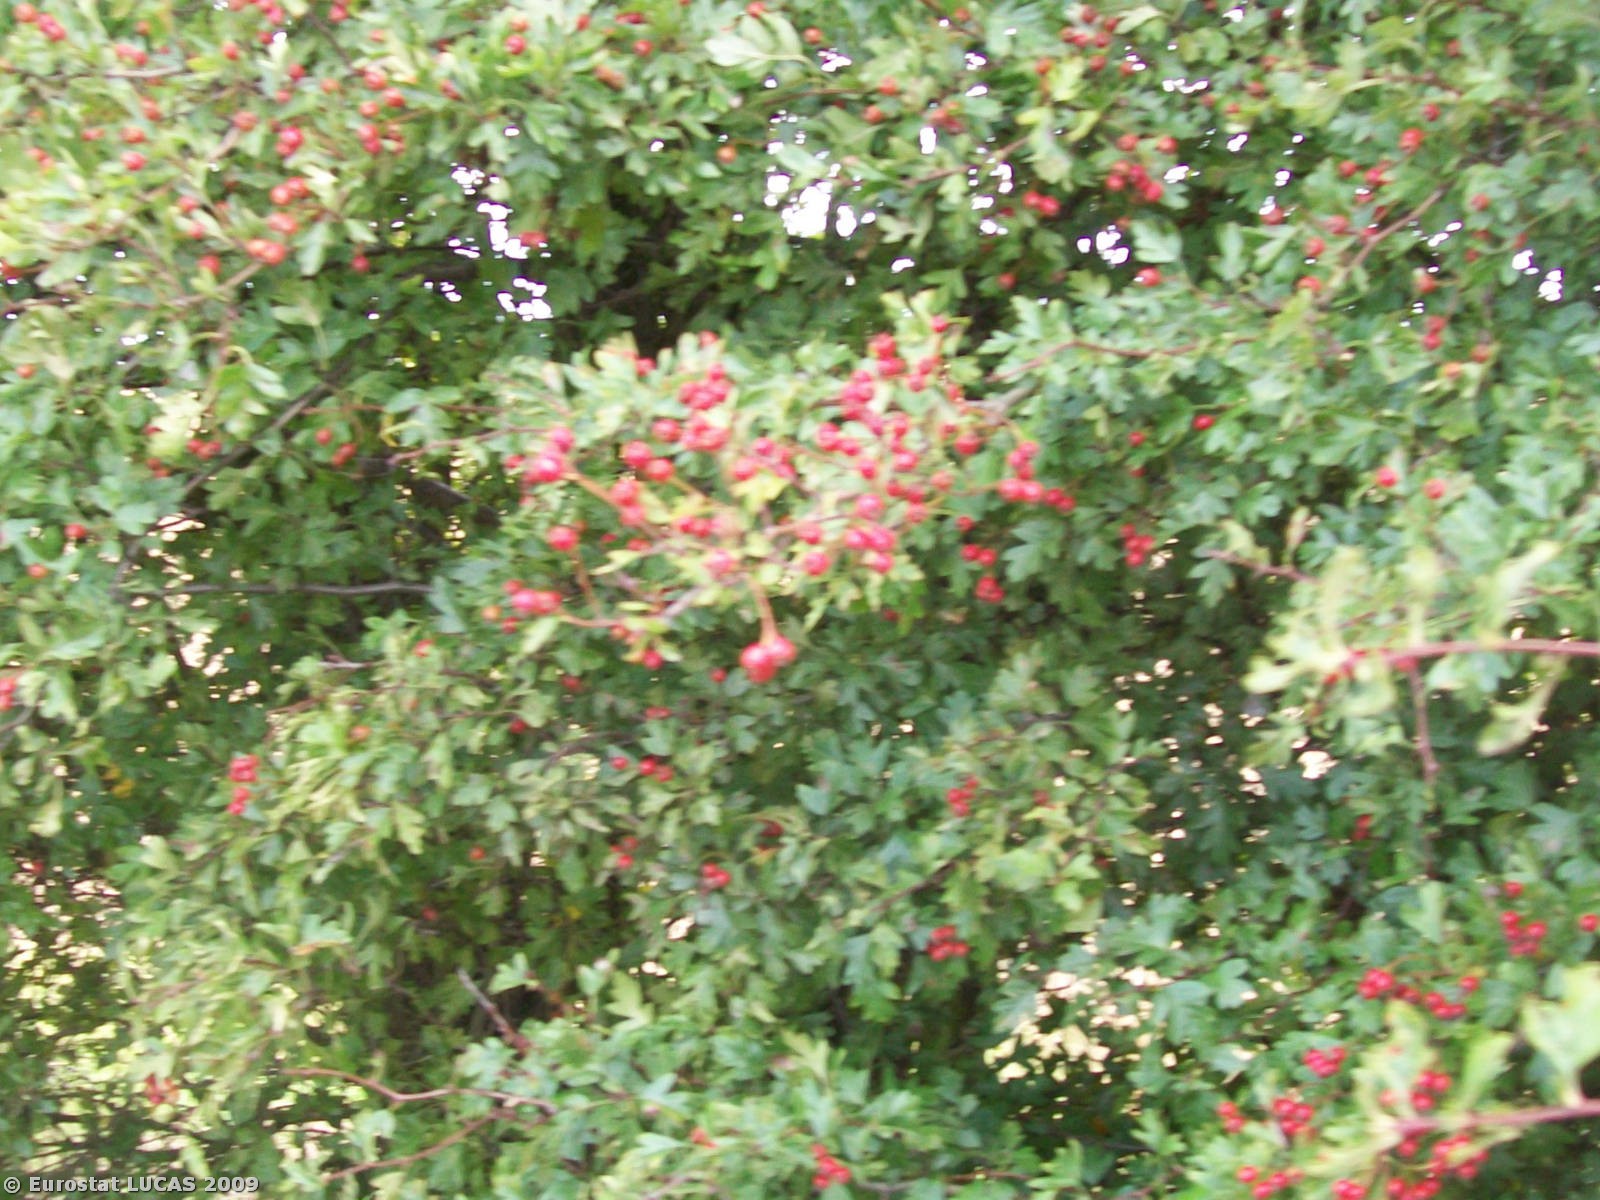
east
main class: Cropland
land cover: Common wheat
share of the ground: < 10 %
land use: Agriculture (excluding fallow land and kitchen gardens)
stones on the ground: 10 - 25 %
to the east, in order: Common wheat; Electric lines; Bare land
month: August
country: GB
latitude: 51.3972
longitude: 0.2680
